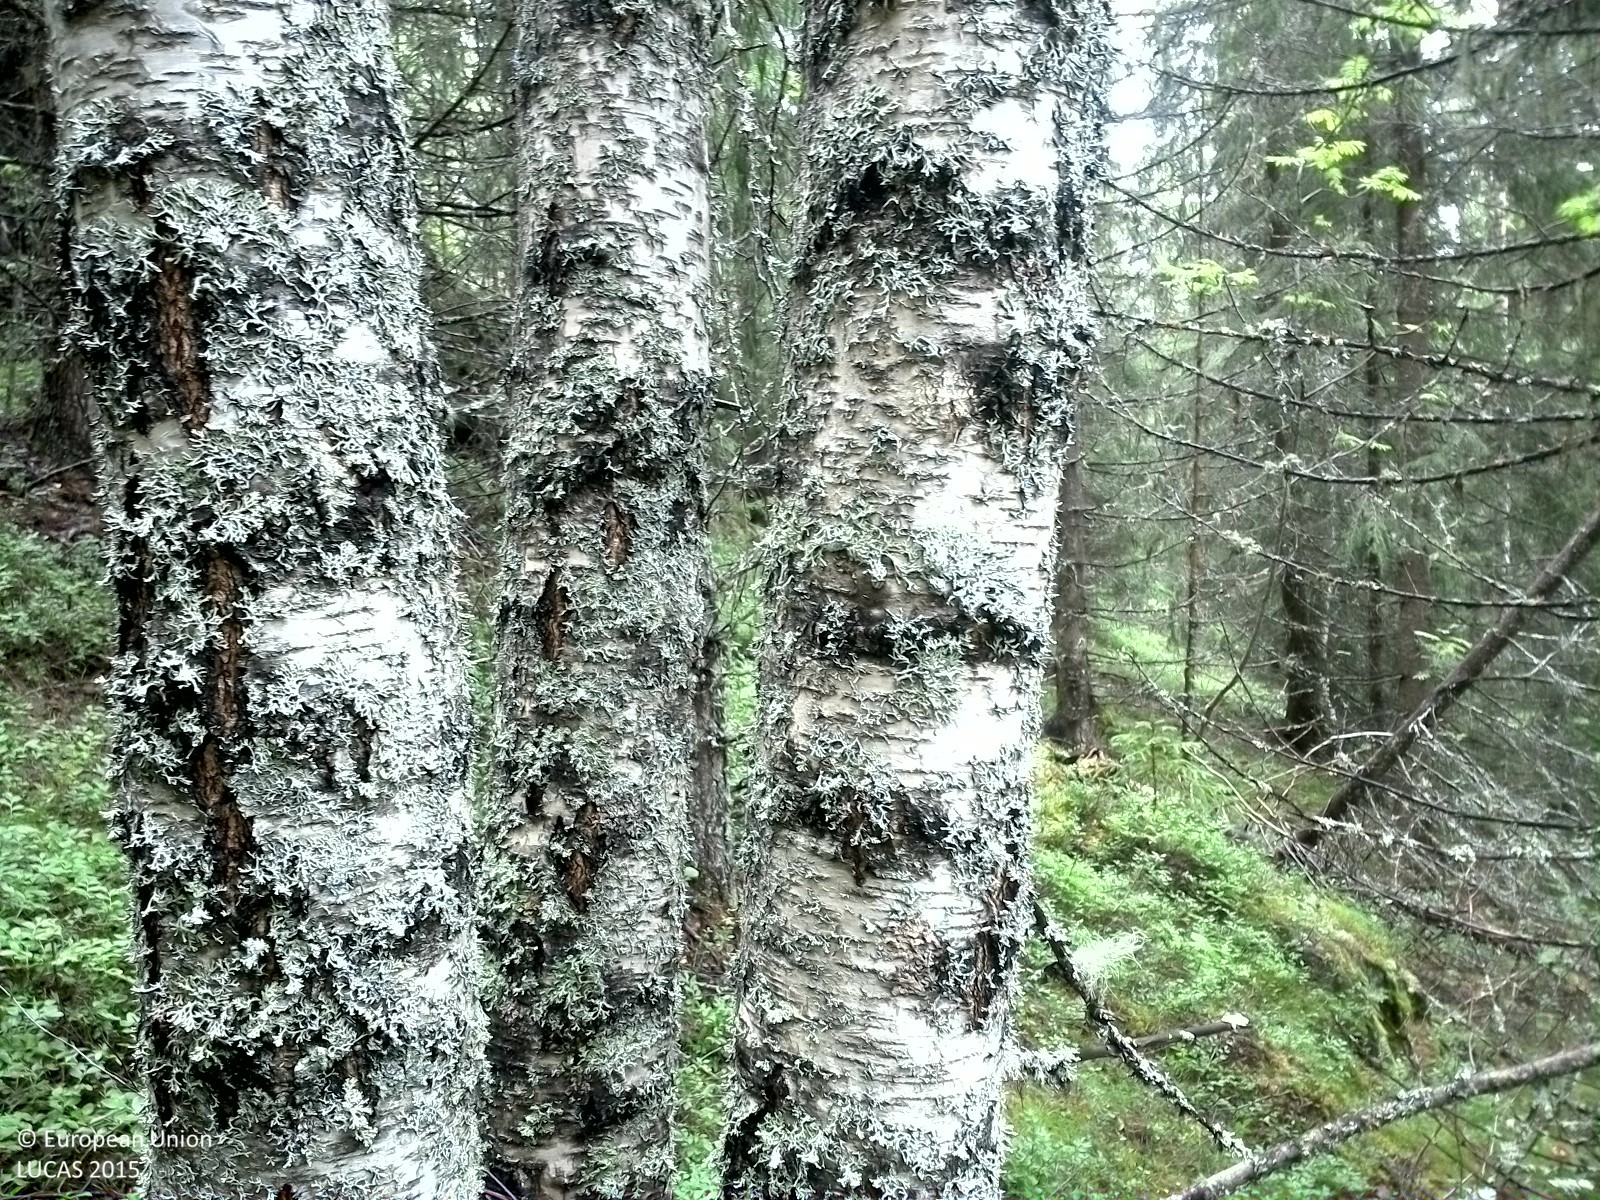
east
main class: Woodland
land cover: Spruce dominated coniferous woodland
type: boreal forest
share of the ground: 50 - 75 %
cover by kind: coniferous forest trees 60 %, shrubs 15 %, lichens and mosses 15 %, broadleaved forest trees 10 %
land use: Forestry
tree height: > 5 m
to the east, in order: Spruce dominated coniferous woodland; Spruce dominated mixed woodland; Spruce dominated coniferous woodland; Peatbogs; Pine dominated coniferous woodland
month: August
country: SE
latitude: 62.6566
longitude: 16.8282
